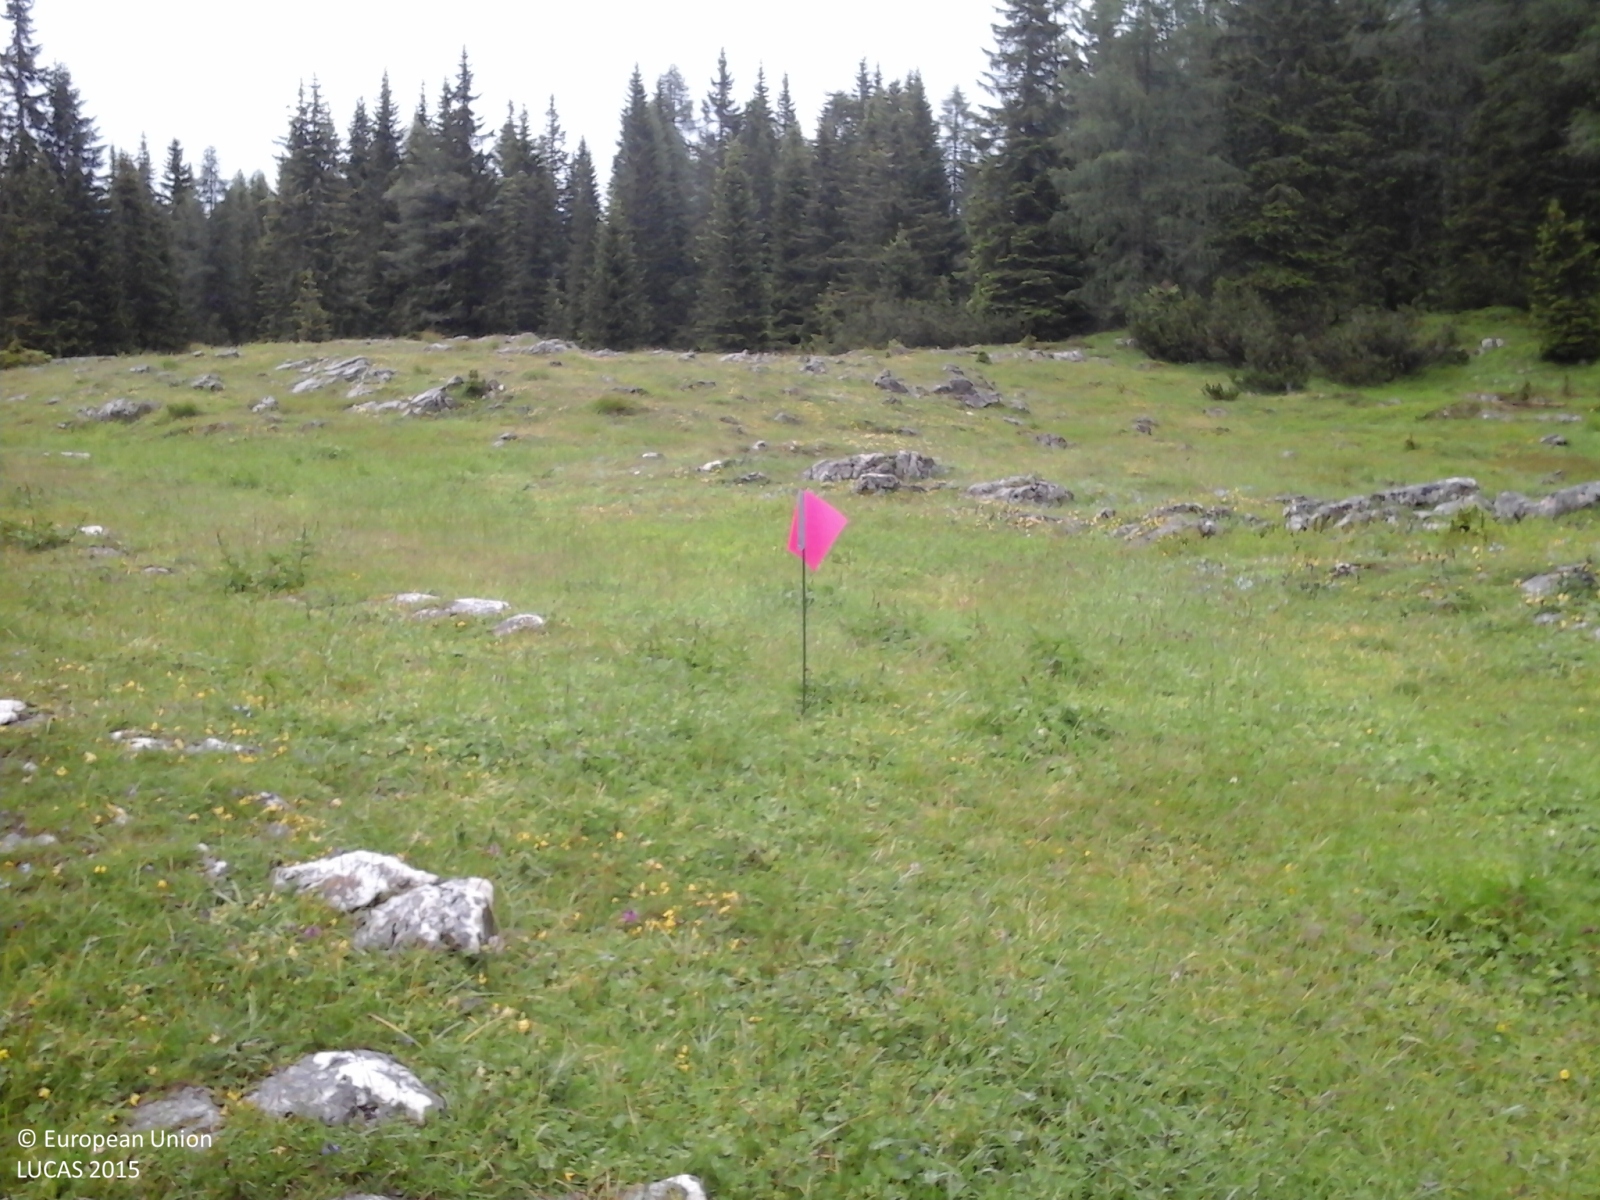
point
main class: Grassland
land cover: Grassland without tree/shrub cover
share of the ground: > 75 %
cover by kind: herbaceous plants 100 %
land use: Agriculture (excluding fallow land and kitchen gardens)
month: June
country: IT
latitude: 45.9799
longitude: 11.5338
